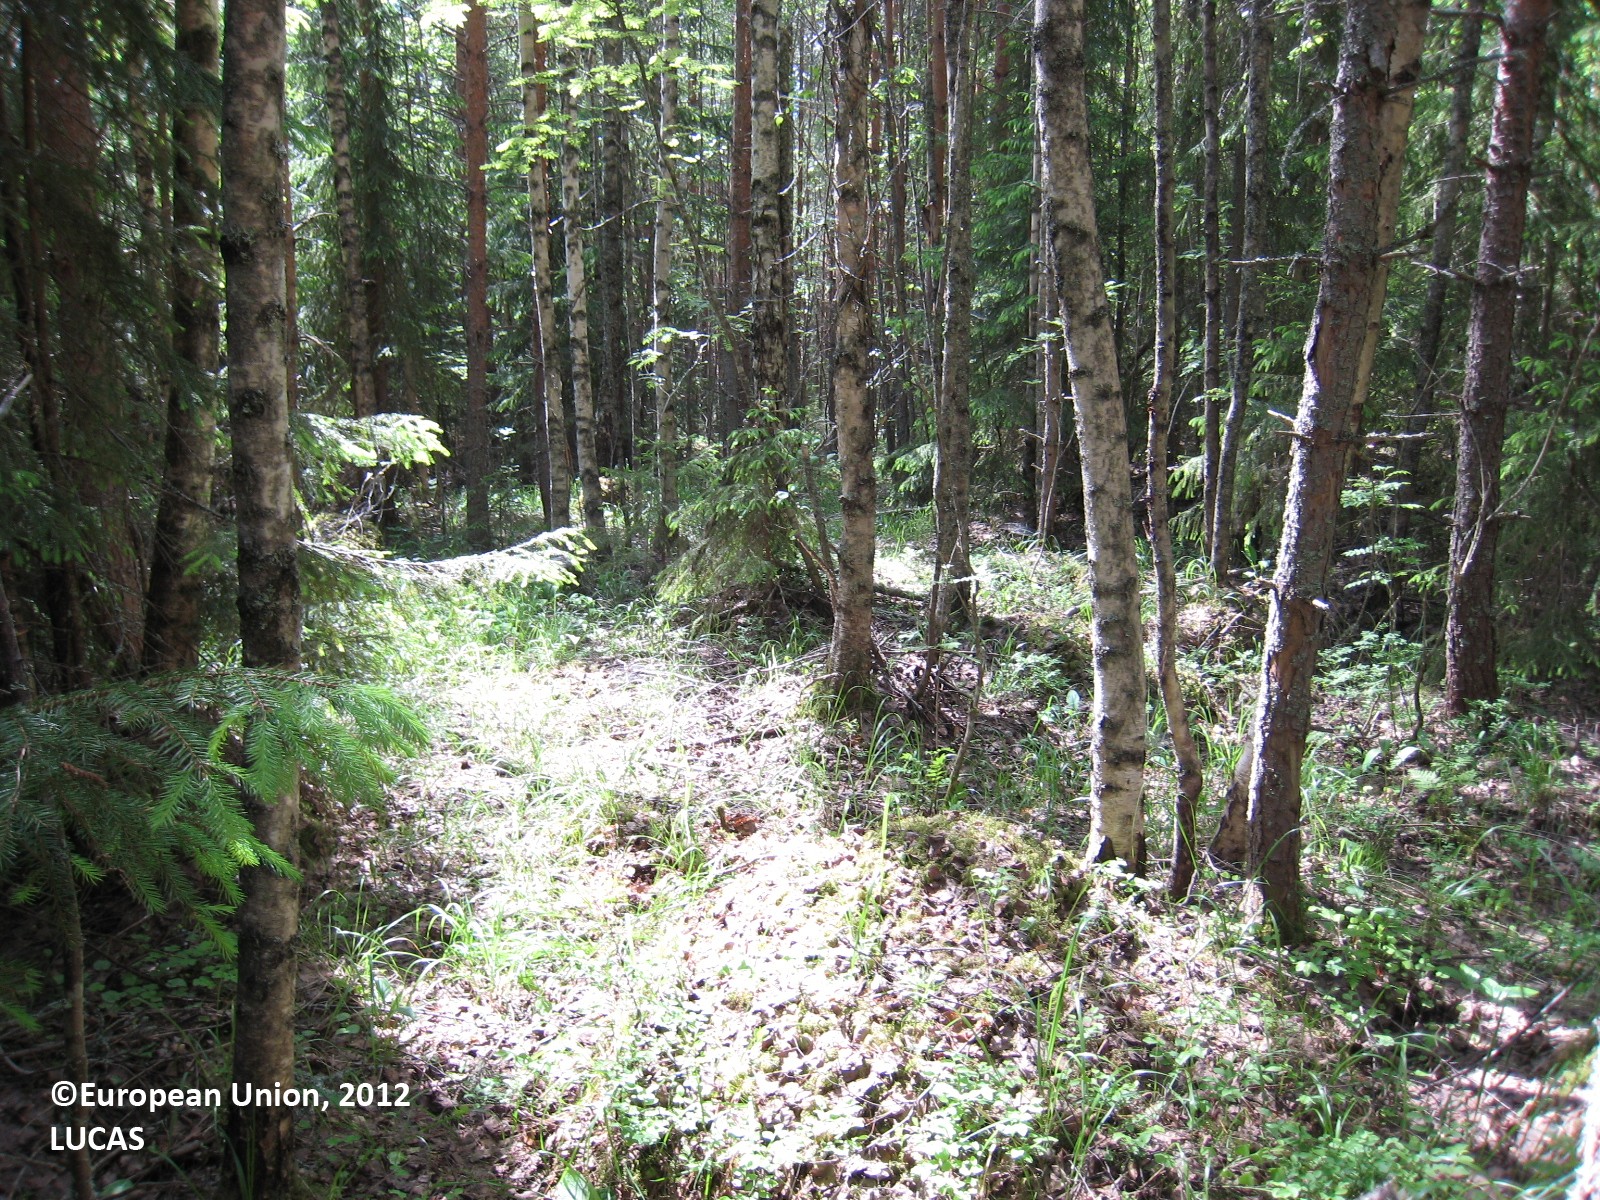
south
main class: Woodland
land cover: Other mixed woodland
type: boreal forest
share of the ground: > 75 %
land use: Forestry
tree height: > 5 m
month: June
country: FI
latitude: 62.0874
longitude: 25.7668
